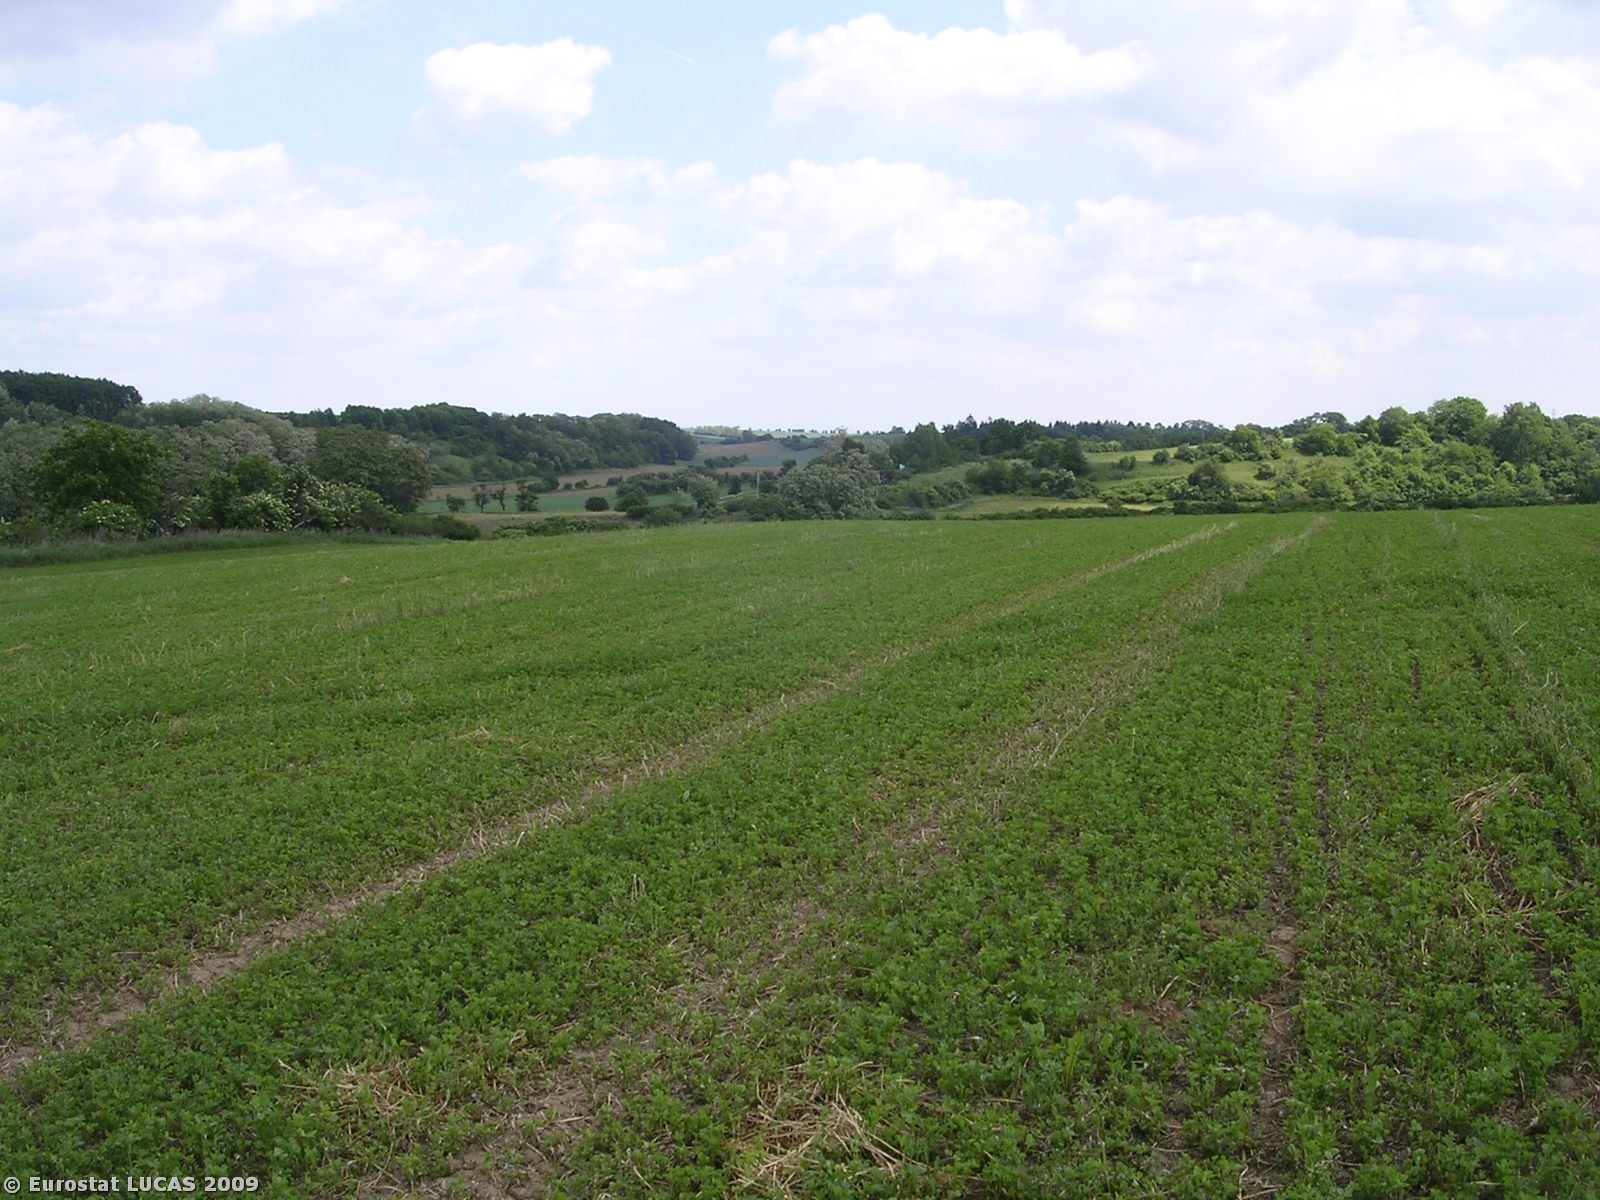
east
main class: Cropland
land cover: Lucerne
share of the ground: > 75 %
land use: Agriculture (excluding fallow land and kitchen gardens)
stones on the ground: < 10 %
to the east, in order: Lucerne; Grassland with sparse tree/shrub cover; Railways; Shrubland with sparse tree cover; Common wheat
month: May
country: CZ
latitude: 50.3212
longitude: 14.7073
